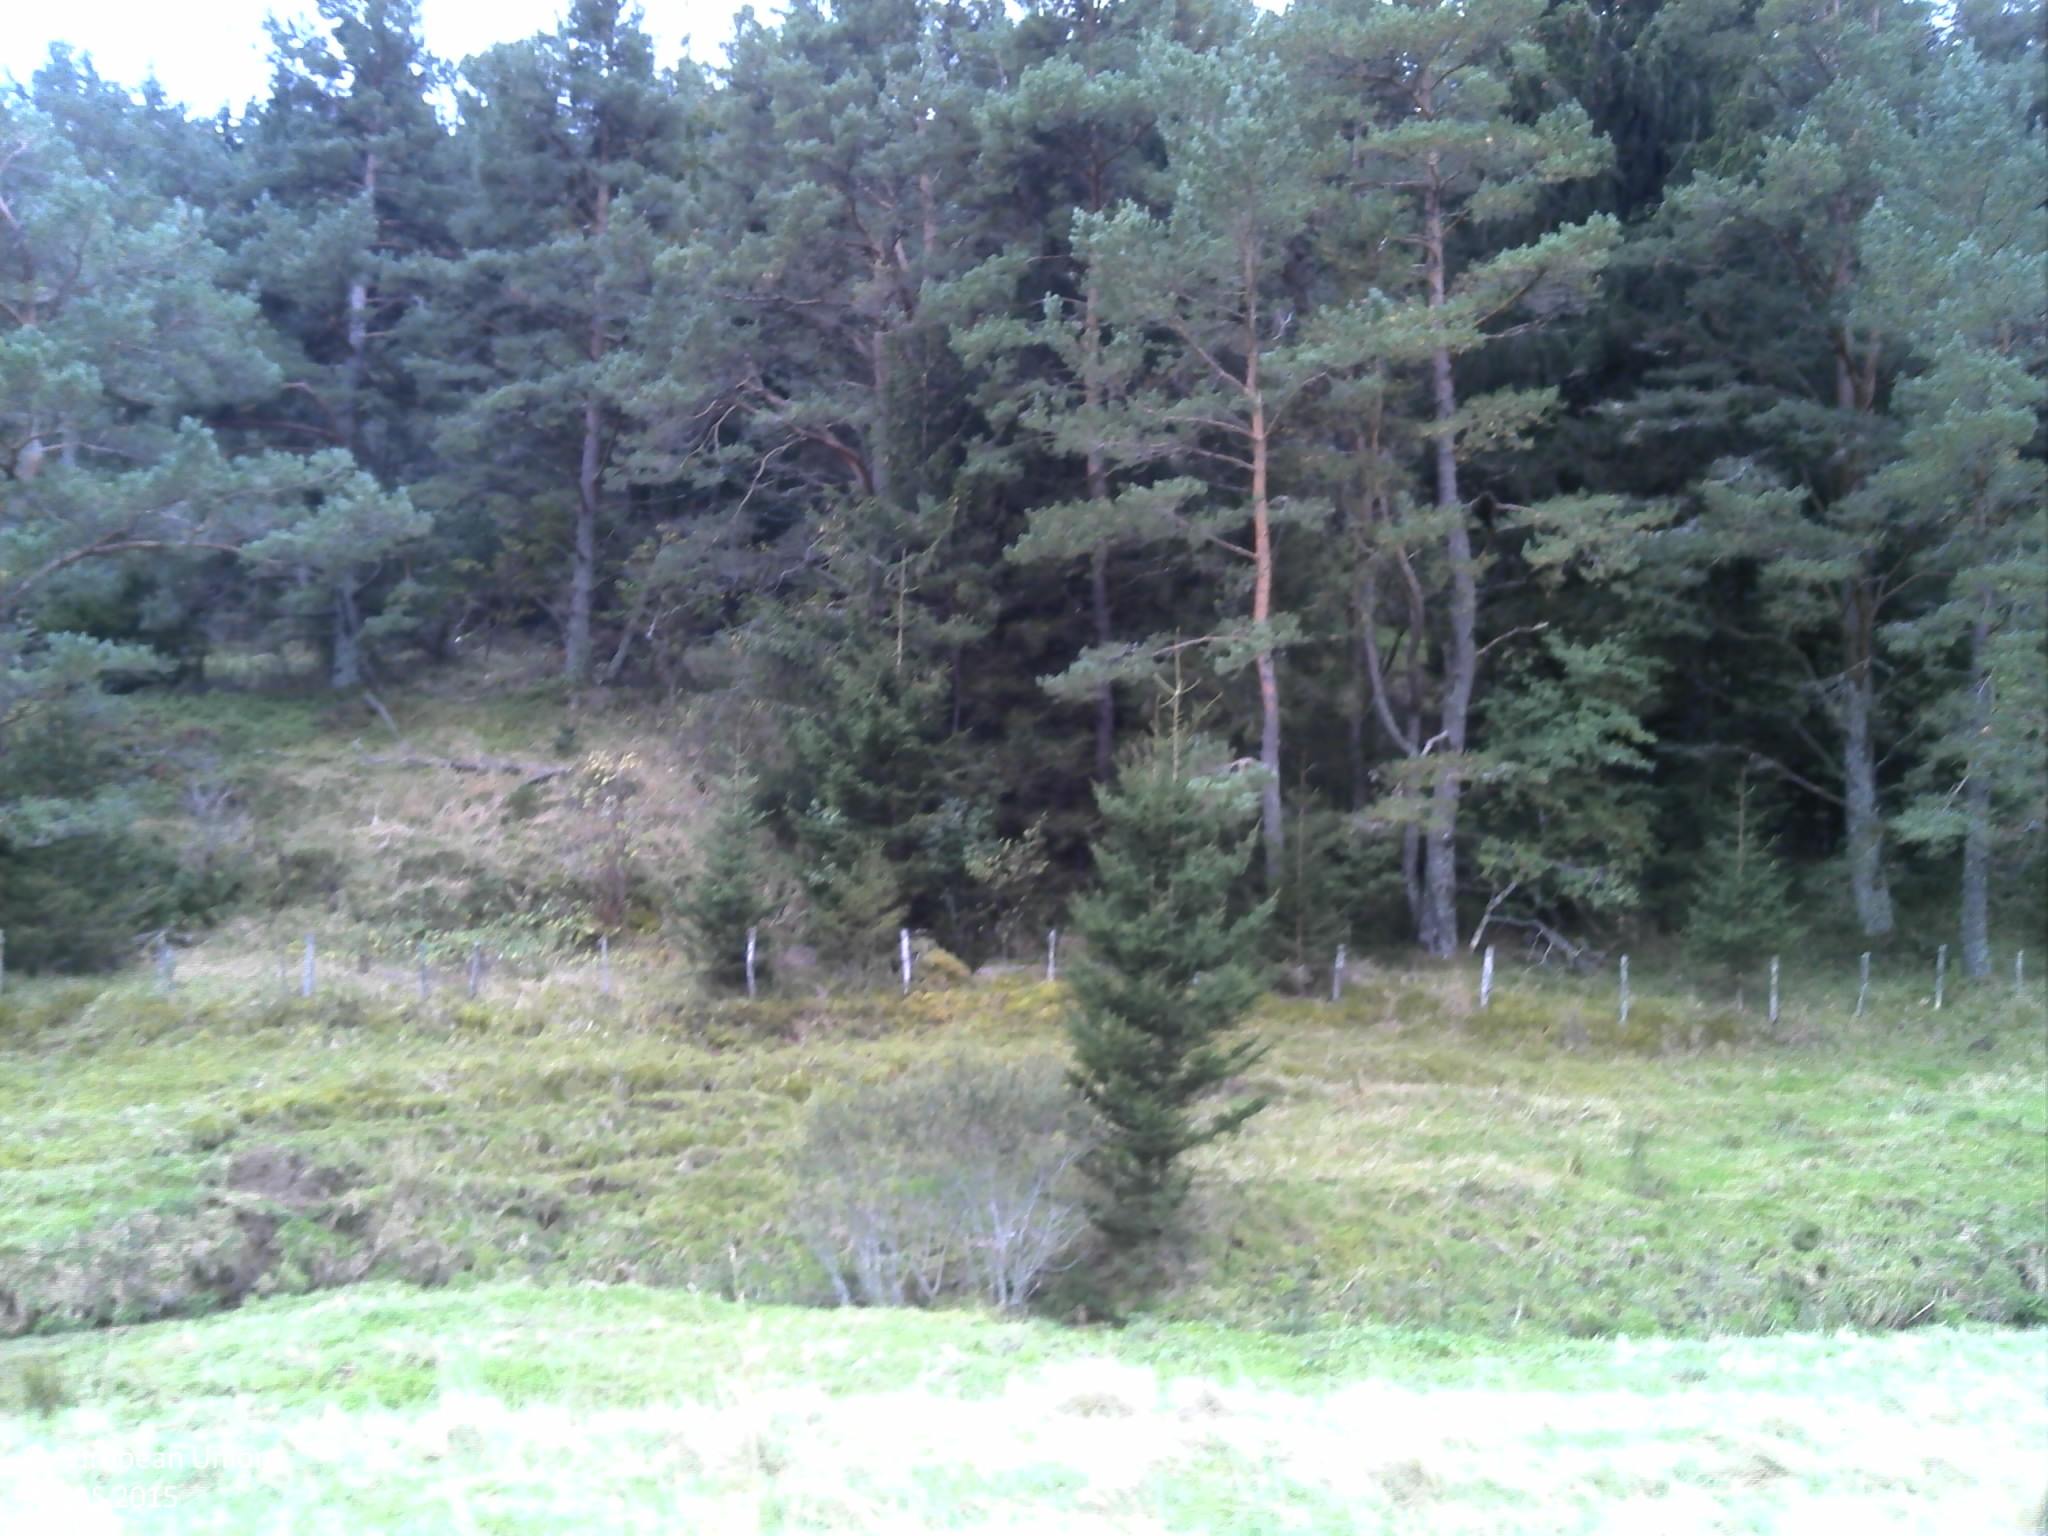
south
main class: Grassland
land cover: Grassland without tree/shrub cover
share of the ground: > 75 %
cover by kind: herbaceous plants 100 %
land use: Agriculture (excluding fallow land and kitchen gardens)
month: September
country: FR
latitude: 45.5898
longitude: 2.8856
